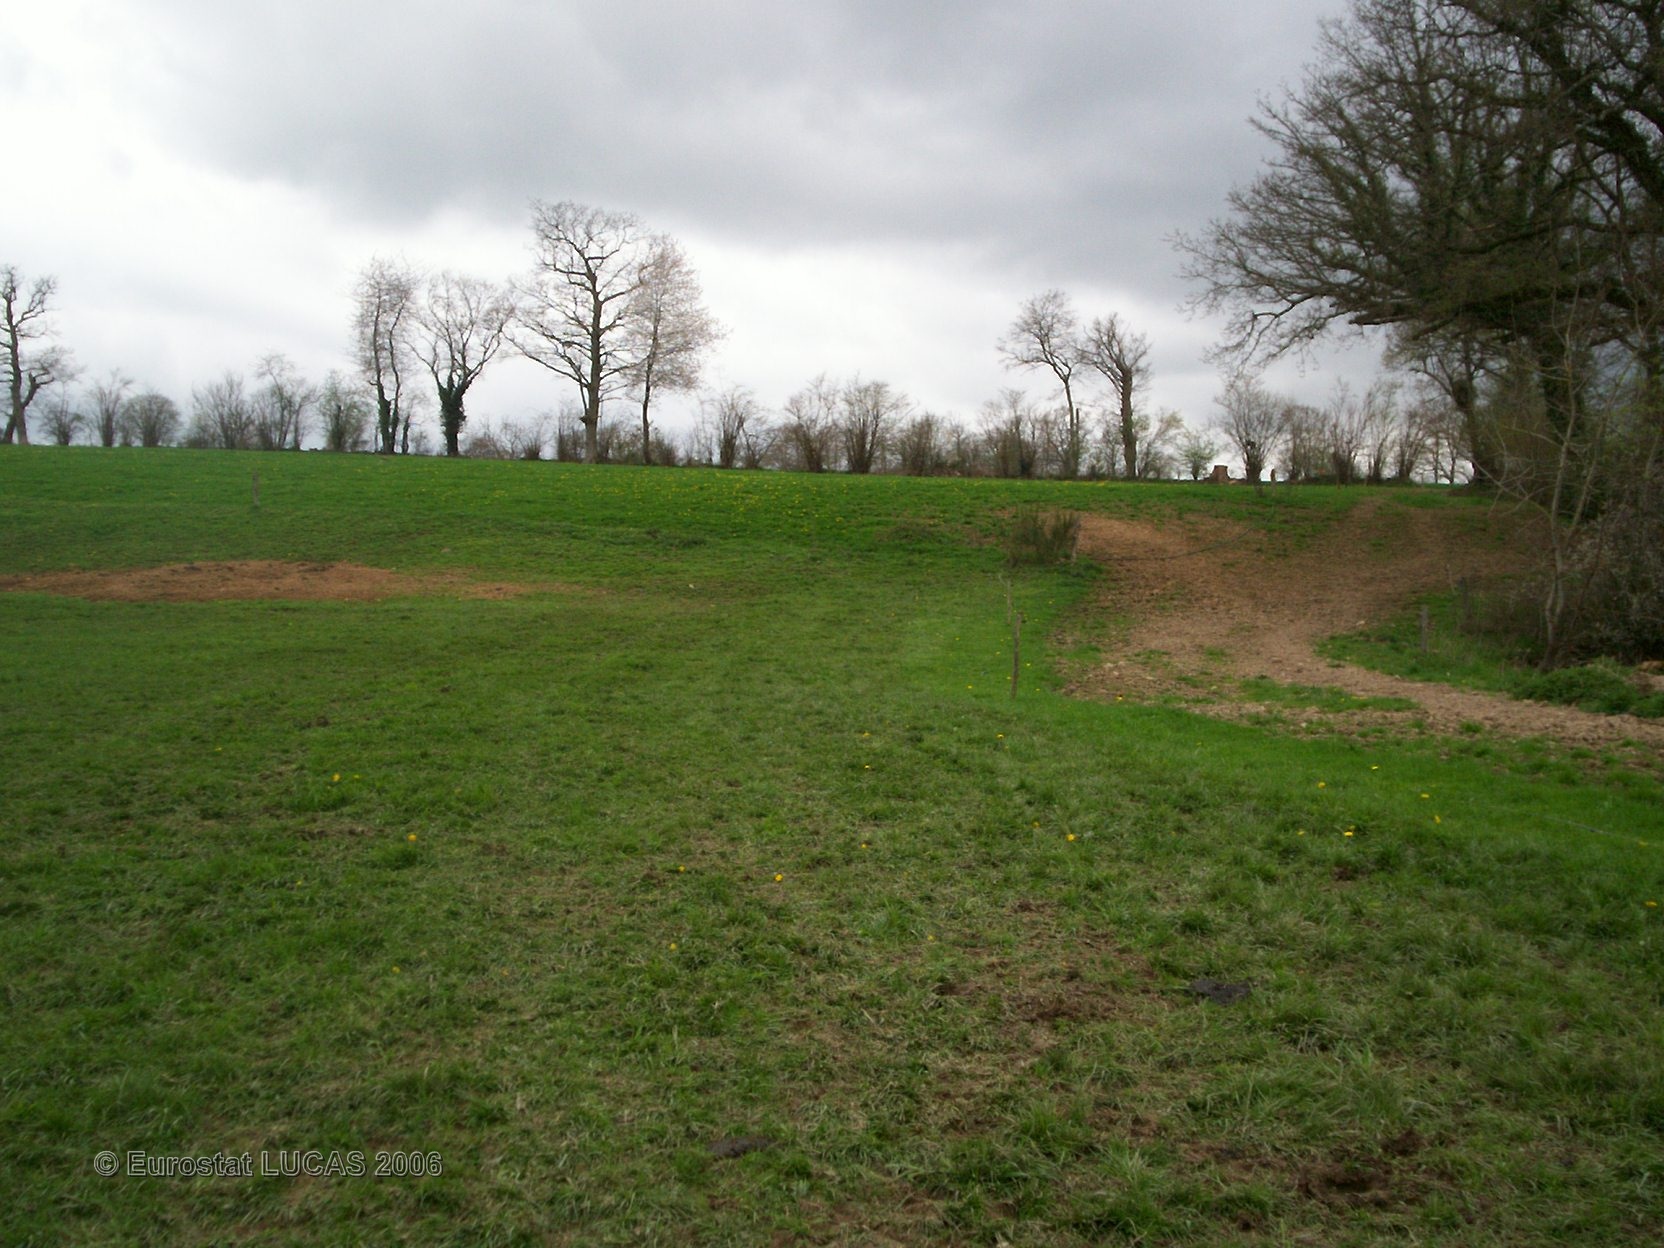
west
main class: Grassland
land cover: Grassland without tree/shrub cover
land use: Agriculture (excluding fallow land and kitchen gardens)
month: April
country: FR
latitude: 48.7146
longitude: -0.3495
